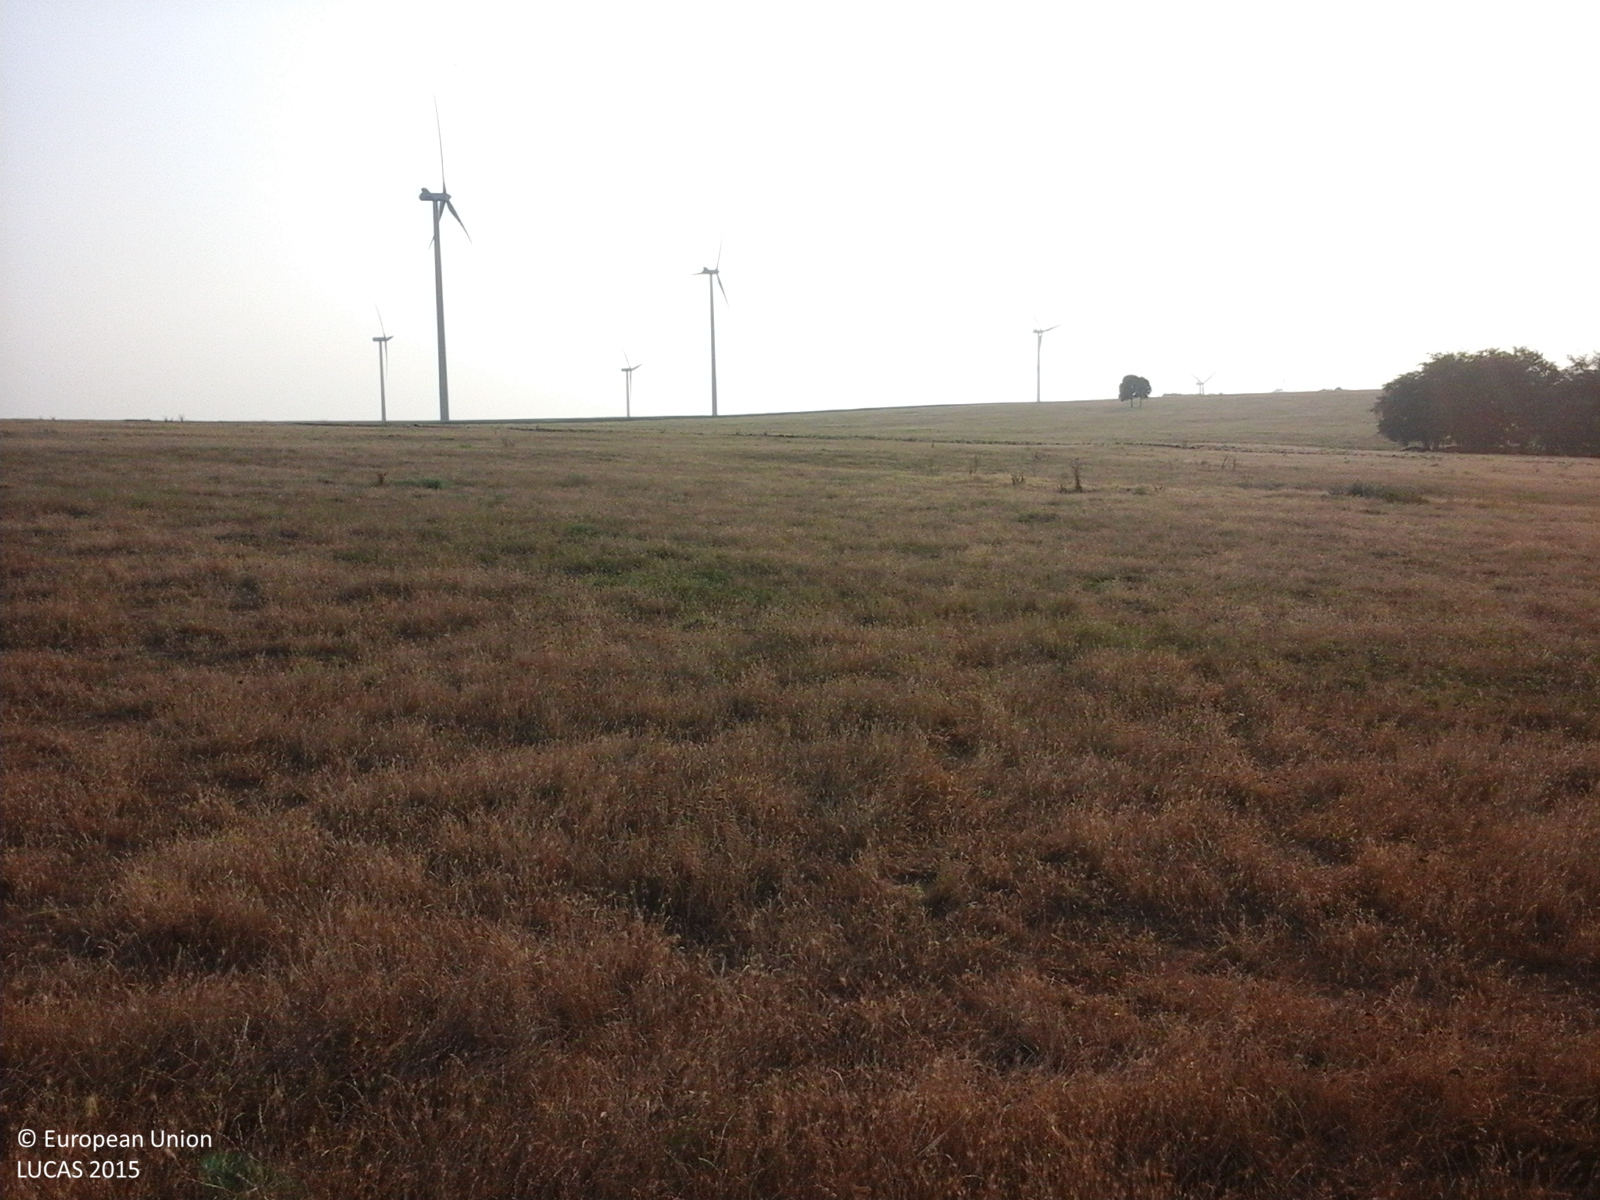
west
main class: Grassland
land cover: Grassland without tree/shrub cover
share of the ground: > 75 %
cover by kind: herbaceous plants 100 %
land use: Agriculture (excluding fallow land and kitchen gardens)
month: July
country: RO
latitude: 44.9075
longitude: 28.3748
